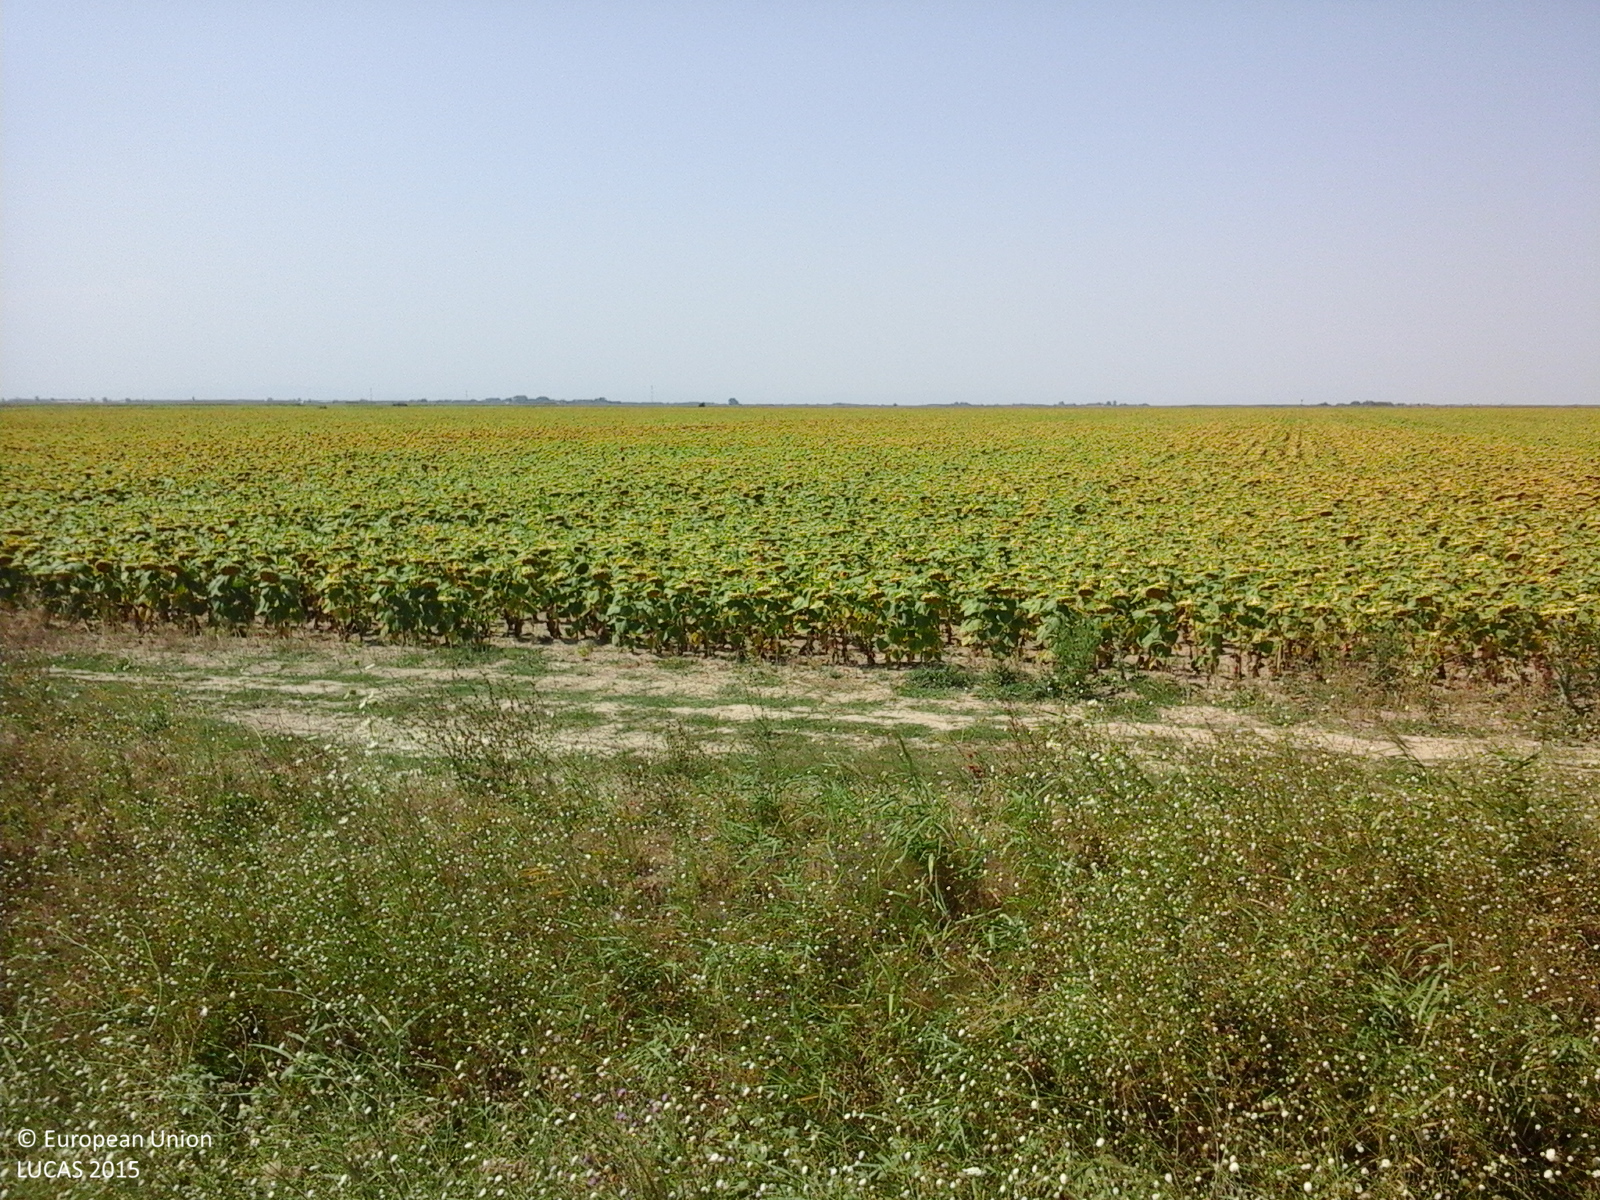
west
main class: Cropland
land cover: Sunflower
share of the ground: > 75 %
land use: Agriculture (excluding fallow land and kitchen gardens)
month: August
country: RO
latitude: 45.4940
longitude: 27.5450
